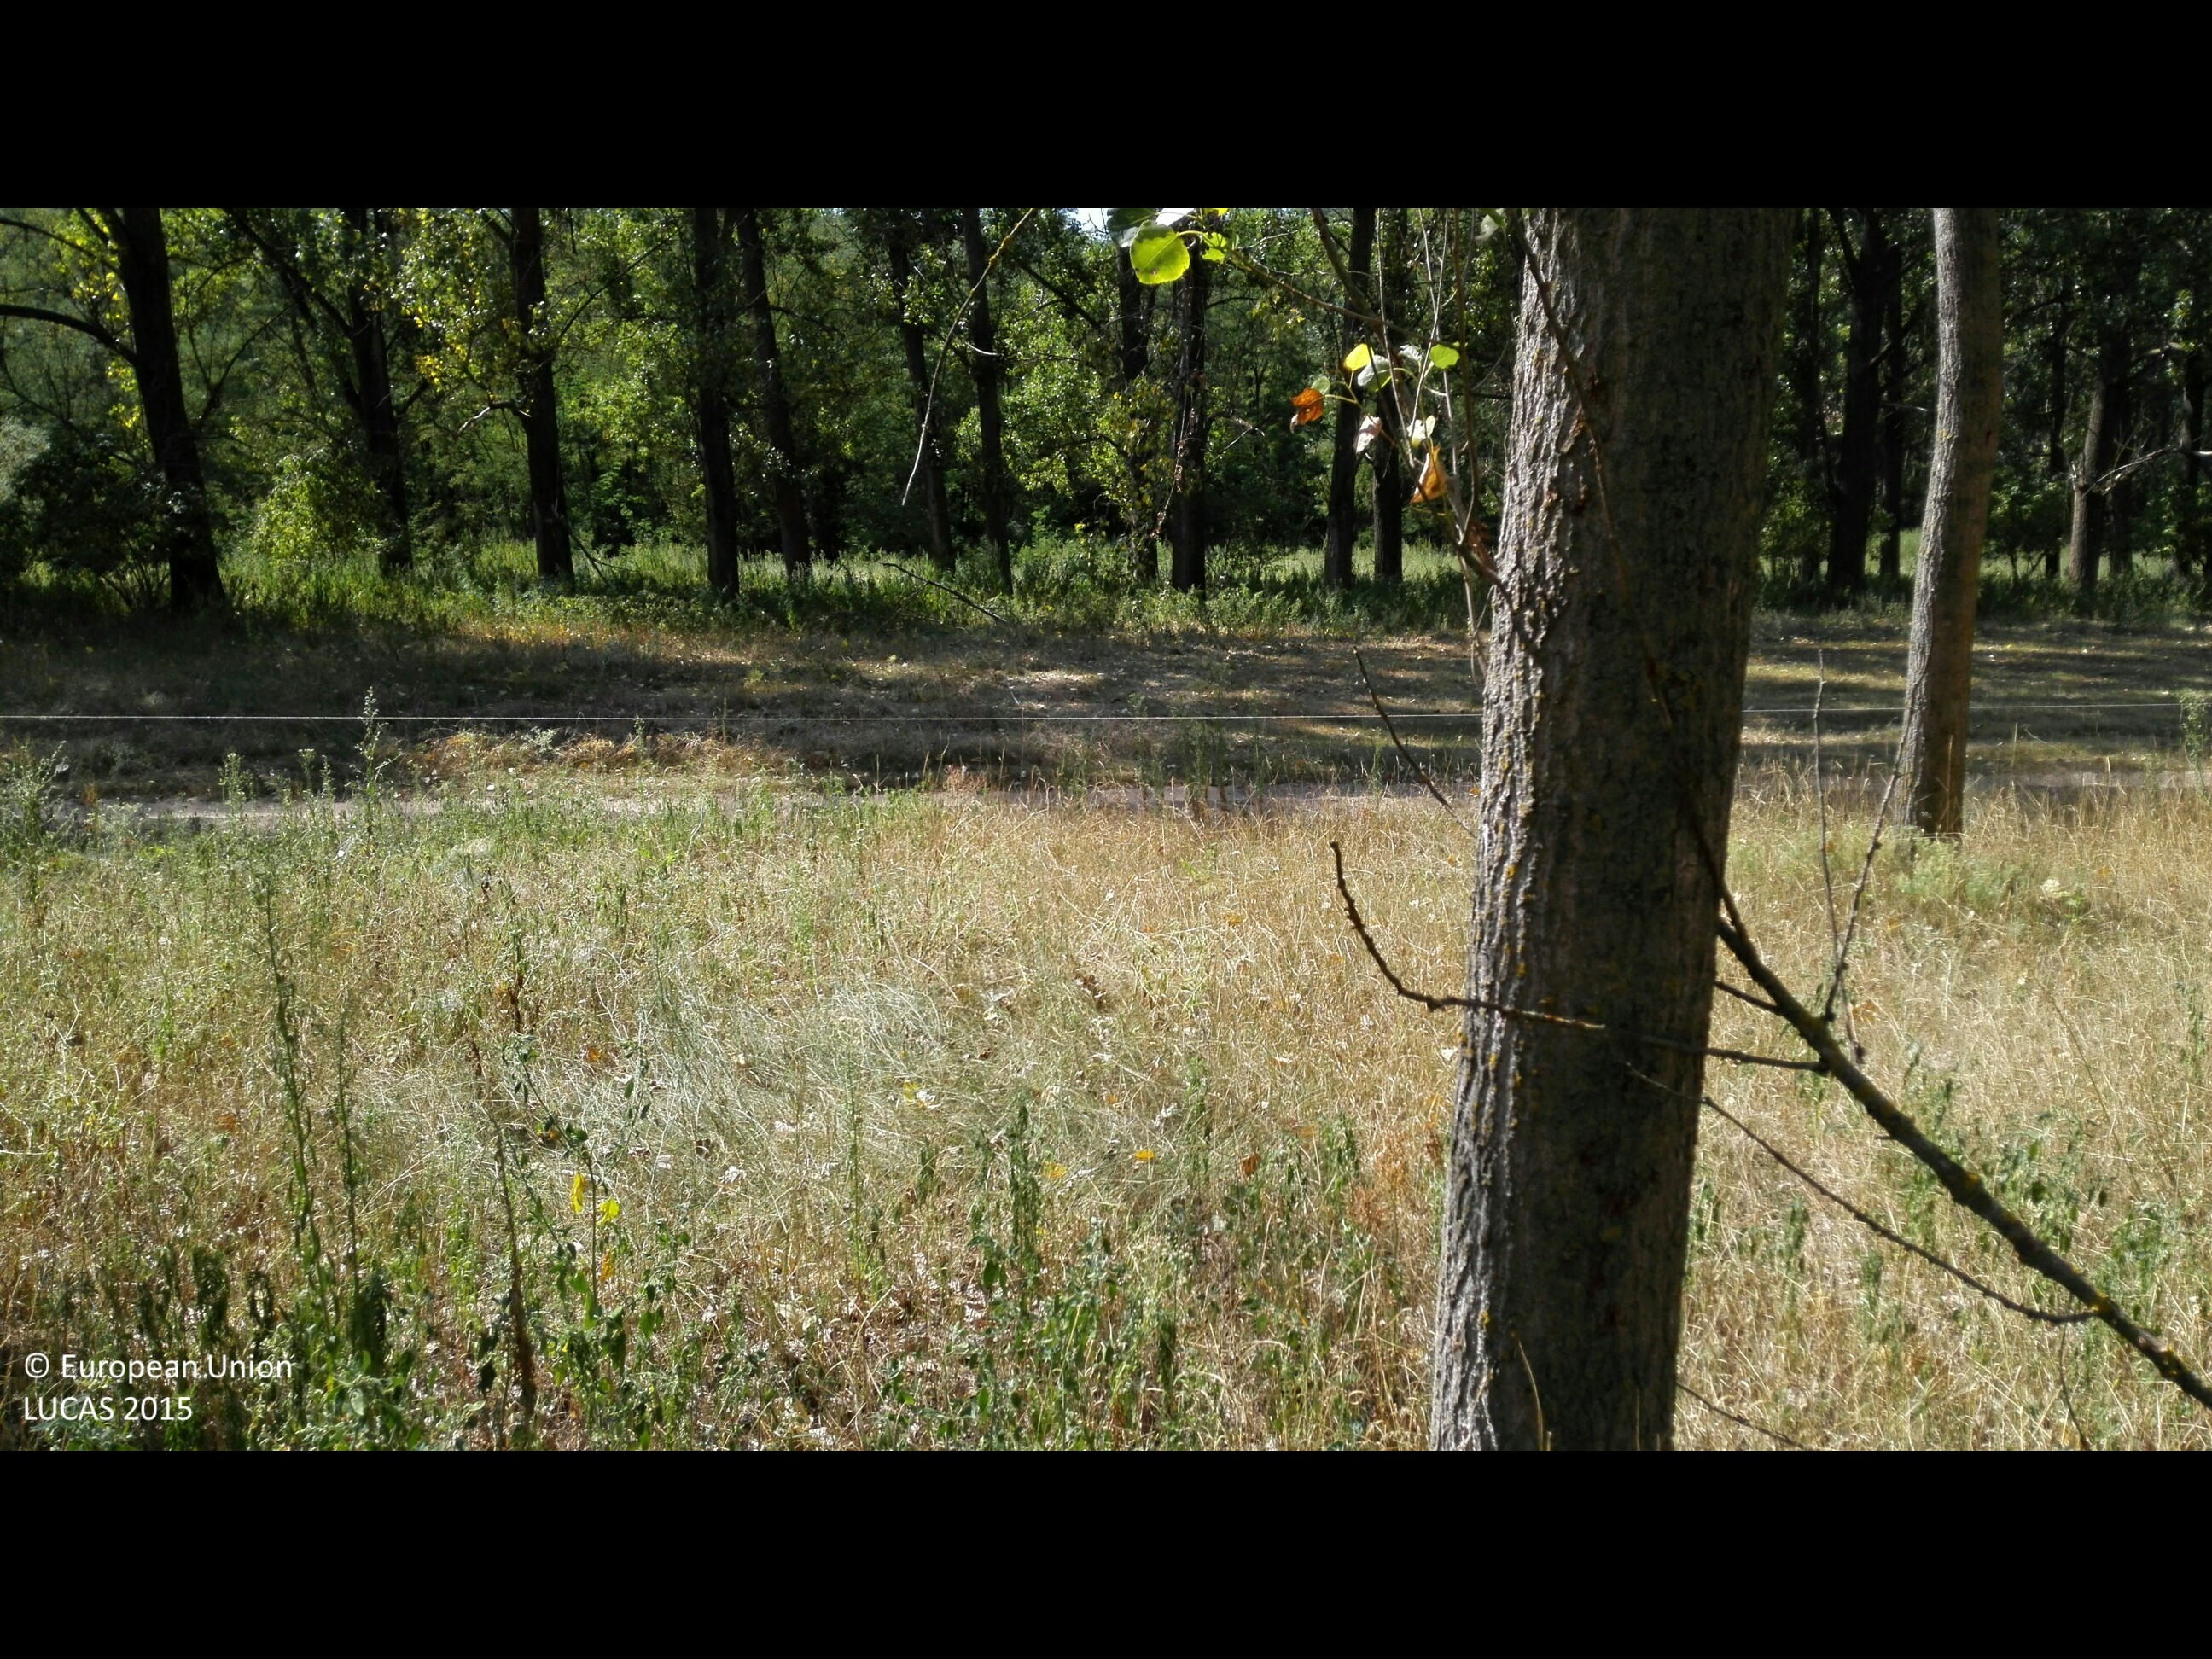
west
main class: Woodland
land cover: Broadleaved woodland
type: non-riverine alder, birch or aspen forest
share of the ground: > 75 %
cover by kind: broadleaved forest trees 90 %, herbaceous plants 10 %
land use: Forestry
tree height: > 5 m
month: August
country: HU
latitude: 47.3939
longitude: 21.9052
